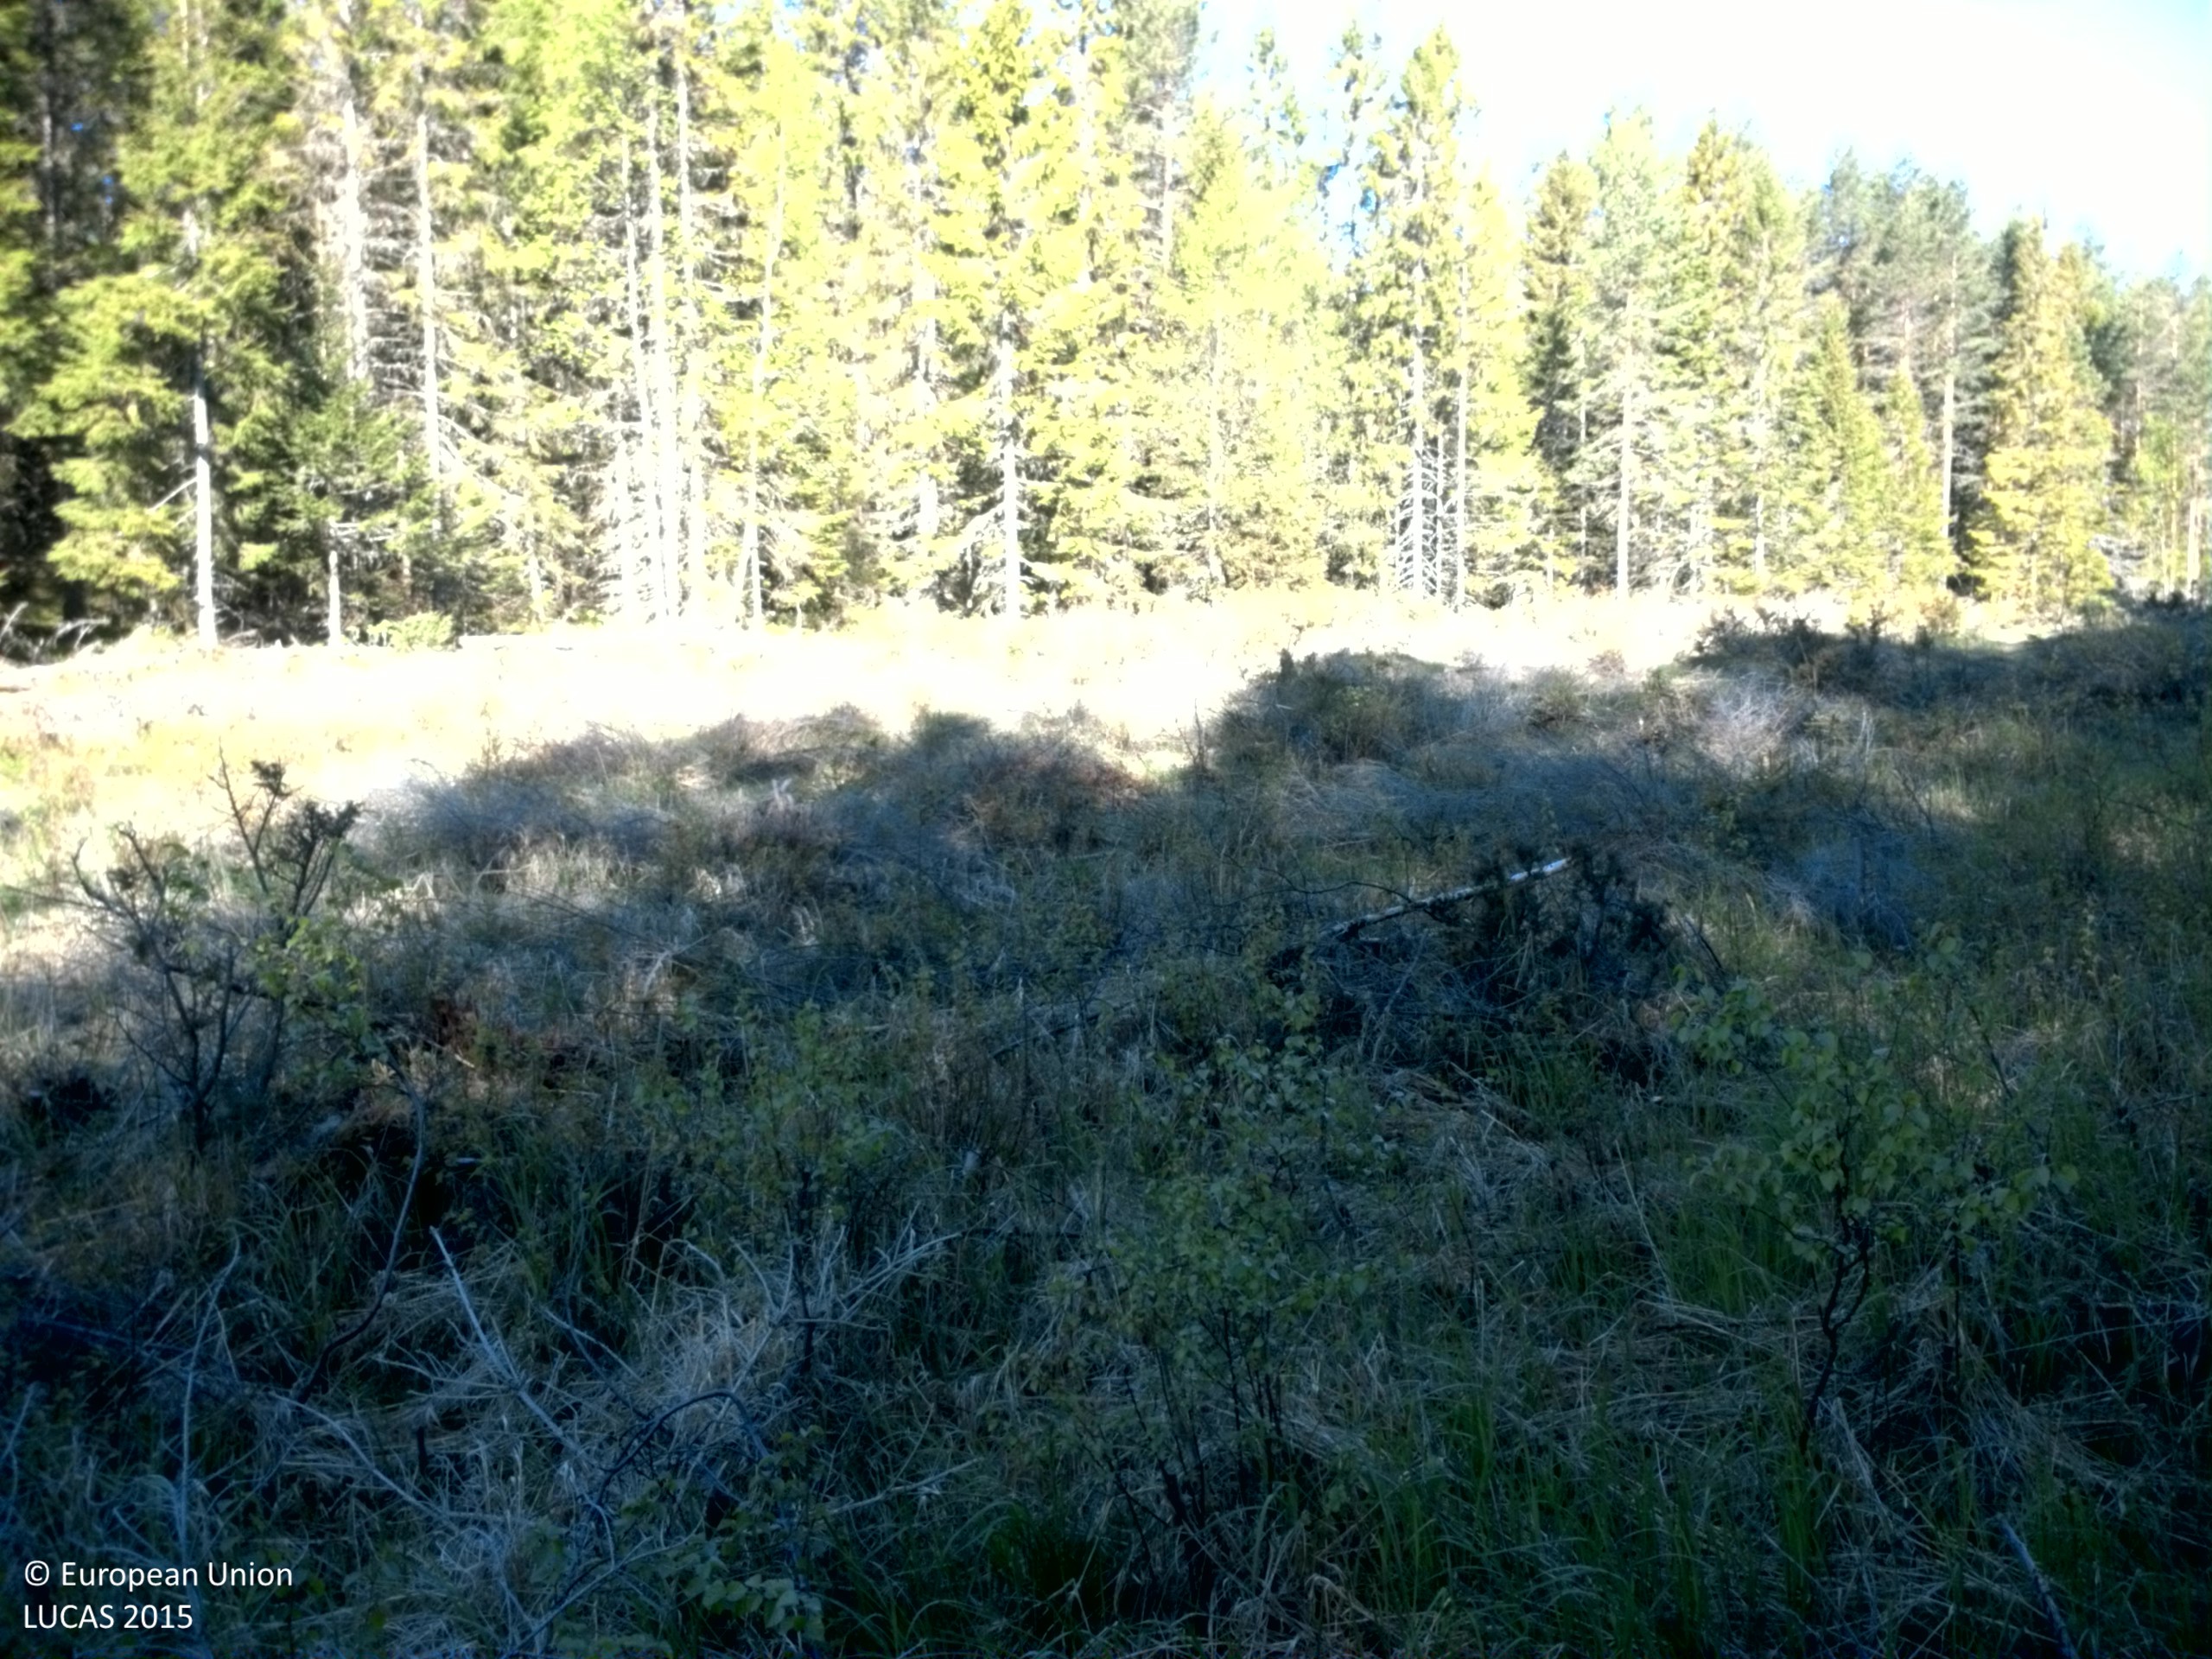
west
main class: Artificial land
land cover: Other artificial areas
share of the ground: > 75 %
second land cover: Broadleaved woodland
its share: 50 - 75 %
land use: Electricity, gas and thermal power distribution
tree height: < 5 m
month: May
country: SE
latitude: 63.0055
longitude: 17.8570
